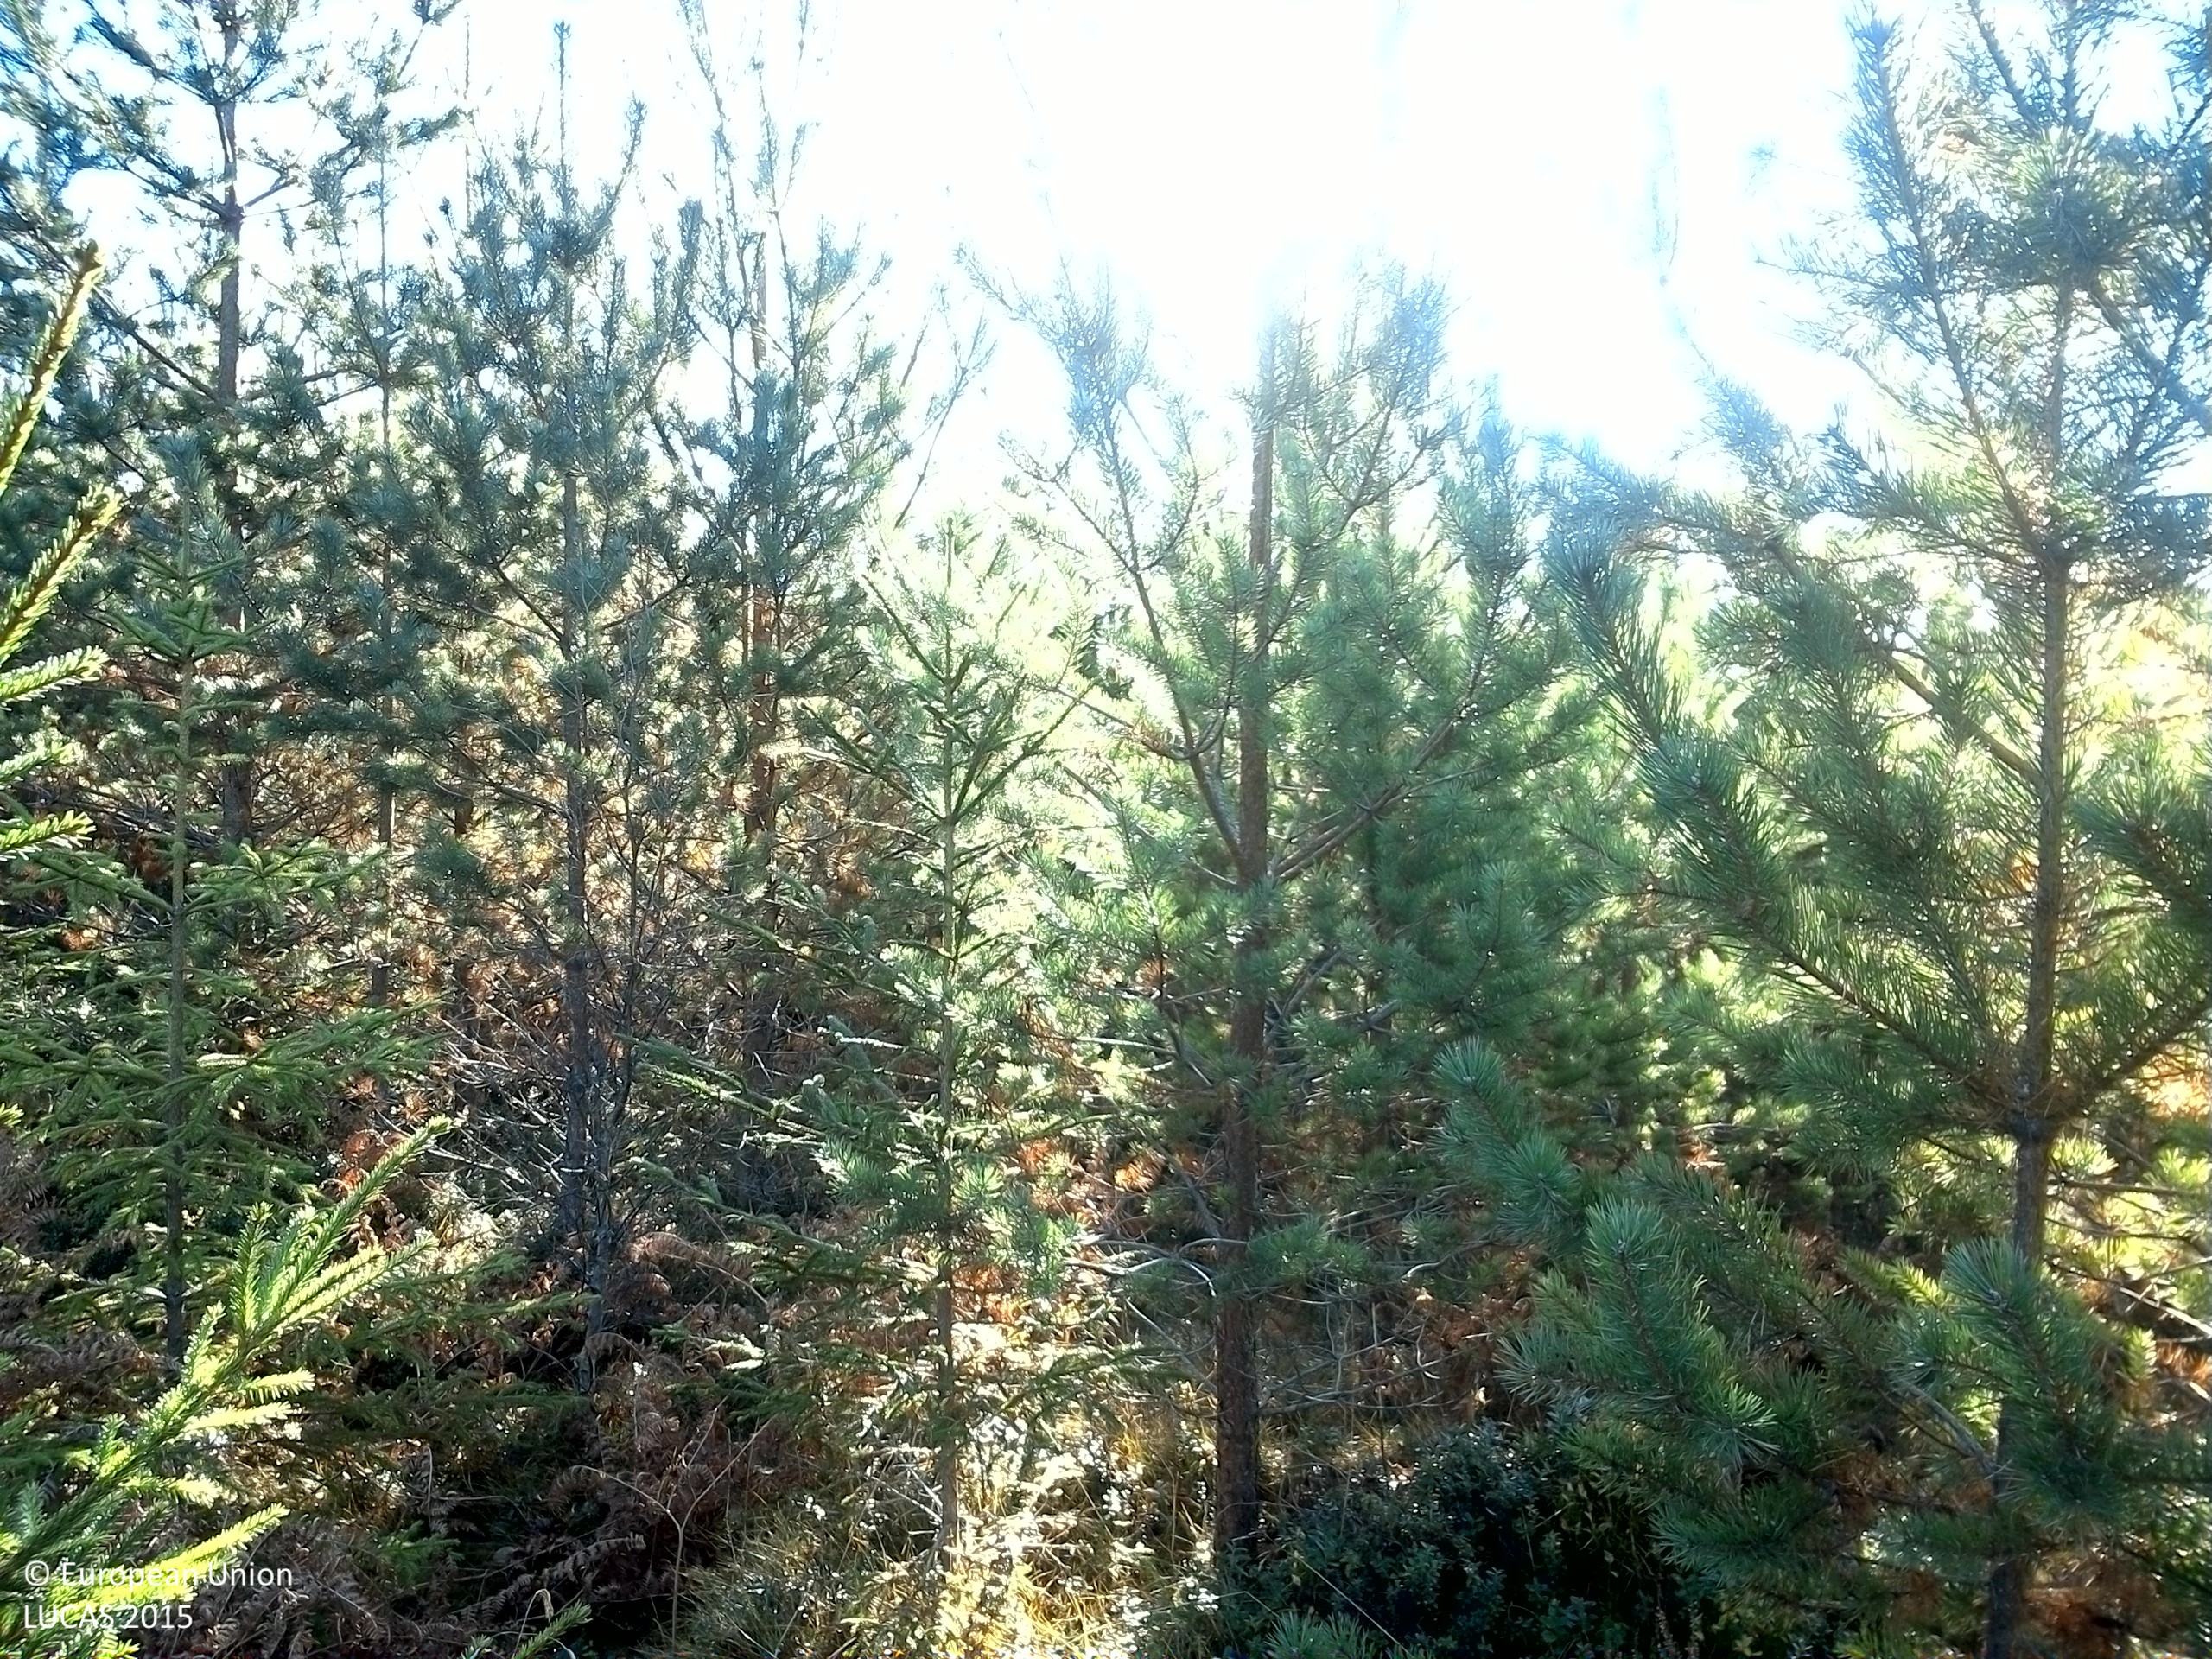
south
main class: Woodland
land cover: Pine dominated coniferous woodland
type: boreal forest
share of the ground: 50 - 75 %
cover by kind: coniferous forest trees 60 %, shrubs 20 %, herbaceous plants 15 %, lichens and mosses 5 %
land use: Forestry
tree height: < 5 m
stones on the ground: 10 - 25 %
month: October
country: SE
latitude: 59.5381
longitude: 14.8539
